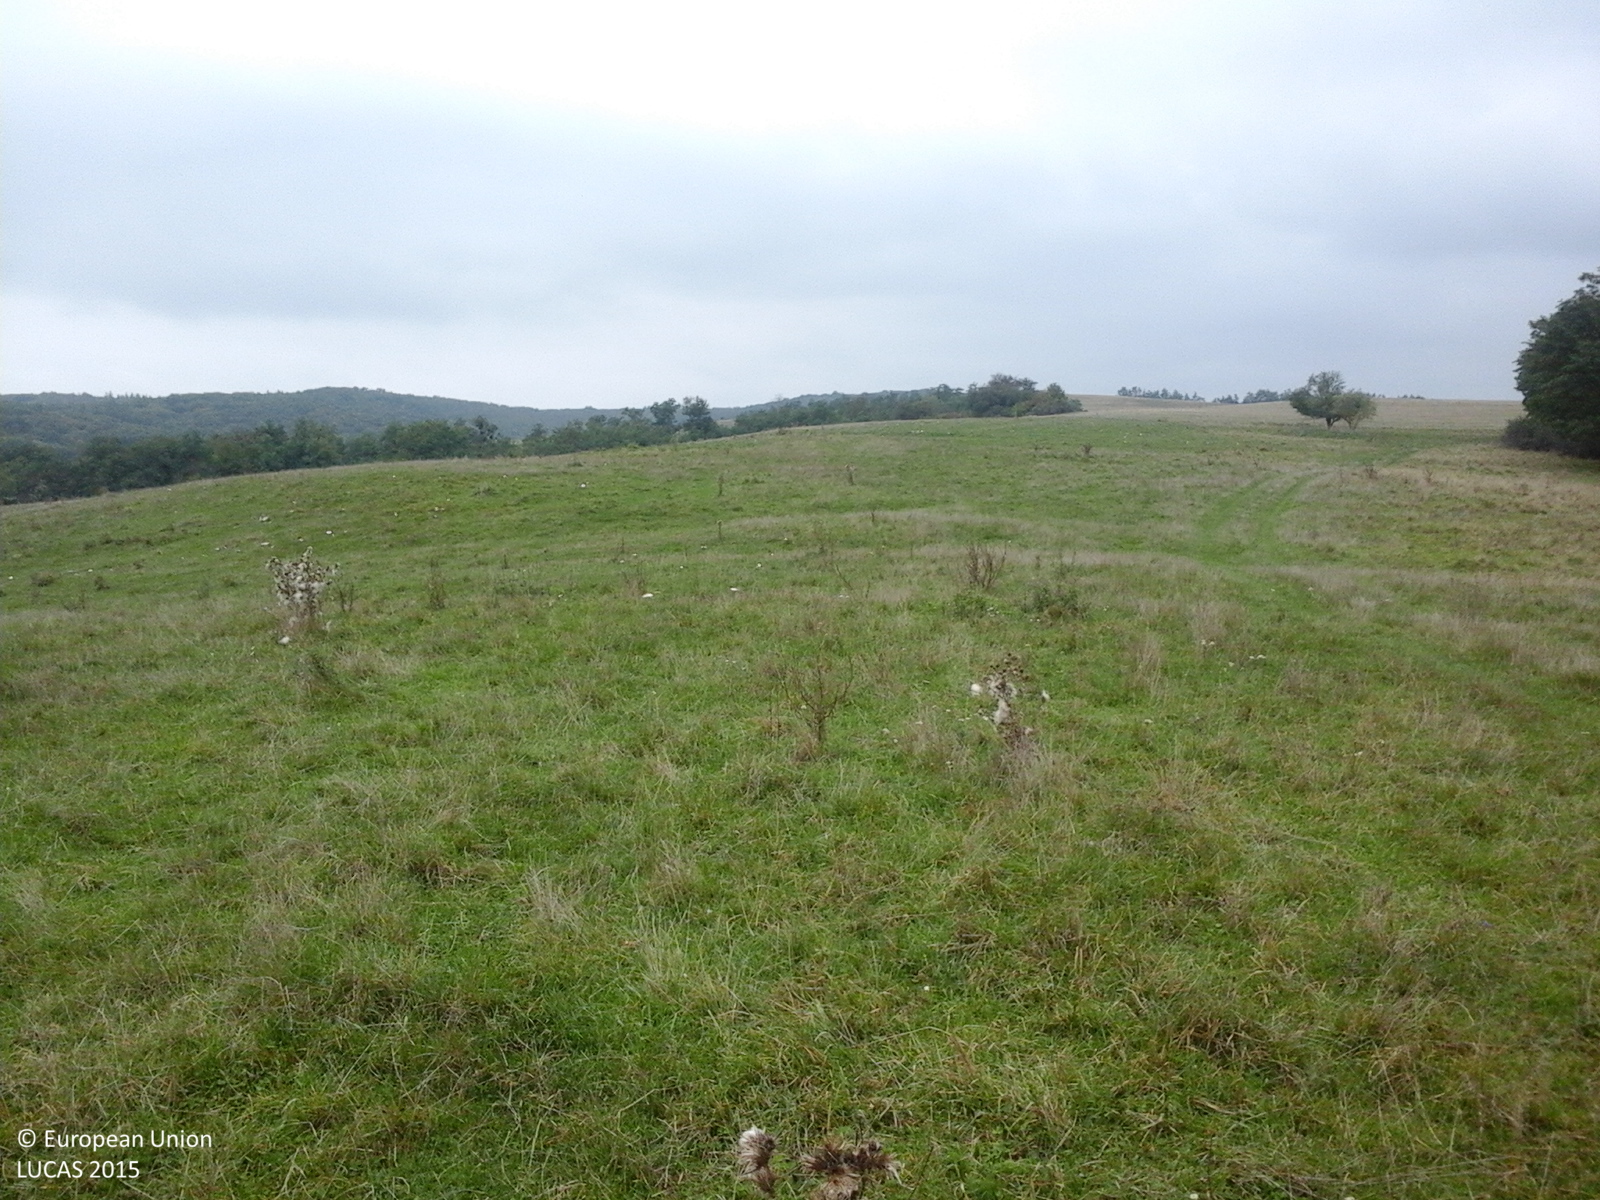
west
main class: Grassland
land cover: Grassland without tree/shrub cover
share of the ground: > 75 %
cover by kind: herbaceous plants 100 %
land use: Agriculture (excluding fallow land and kitchen gardens)
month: October
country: RO
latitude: 46.0408
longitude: 25.0985
